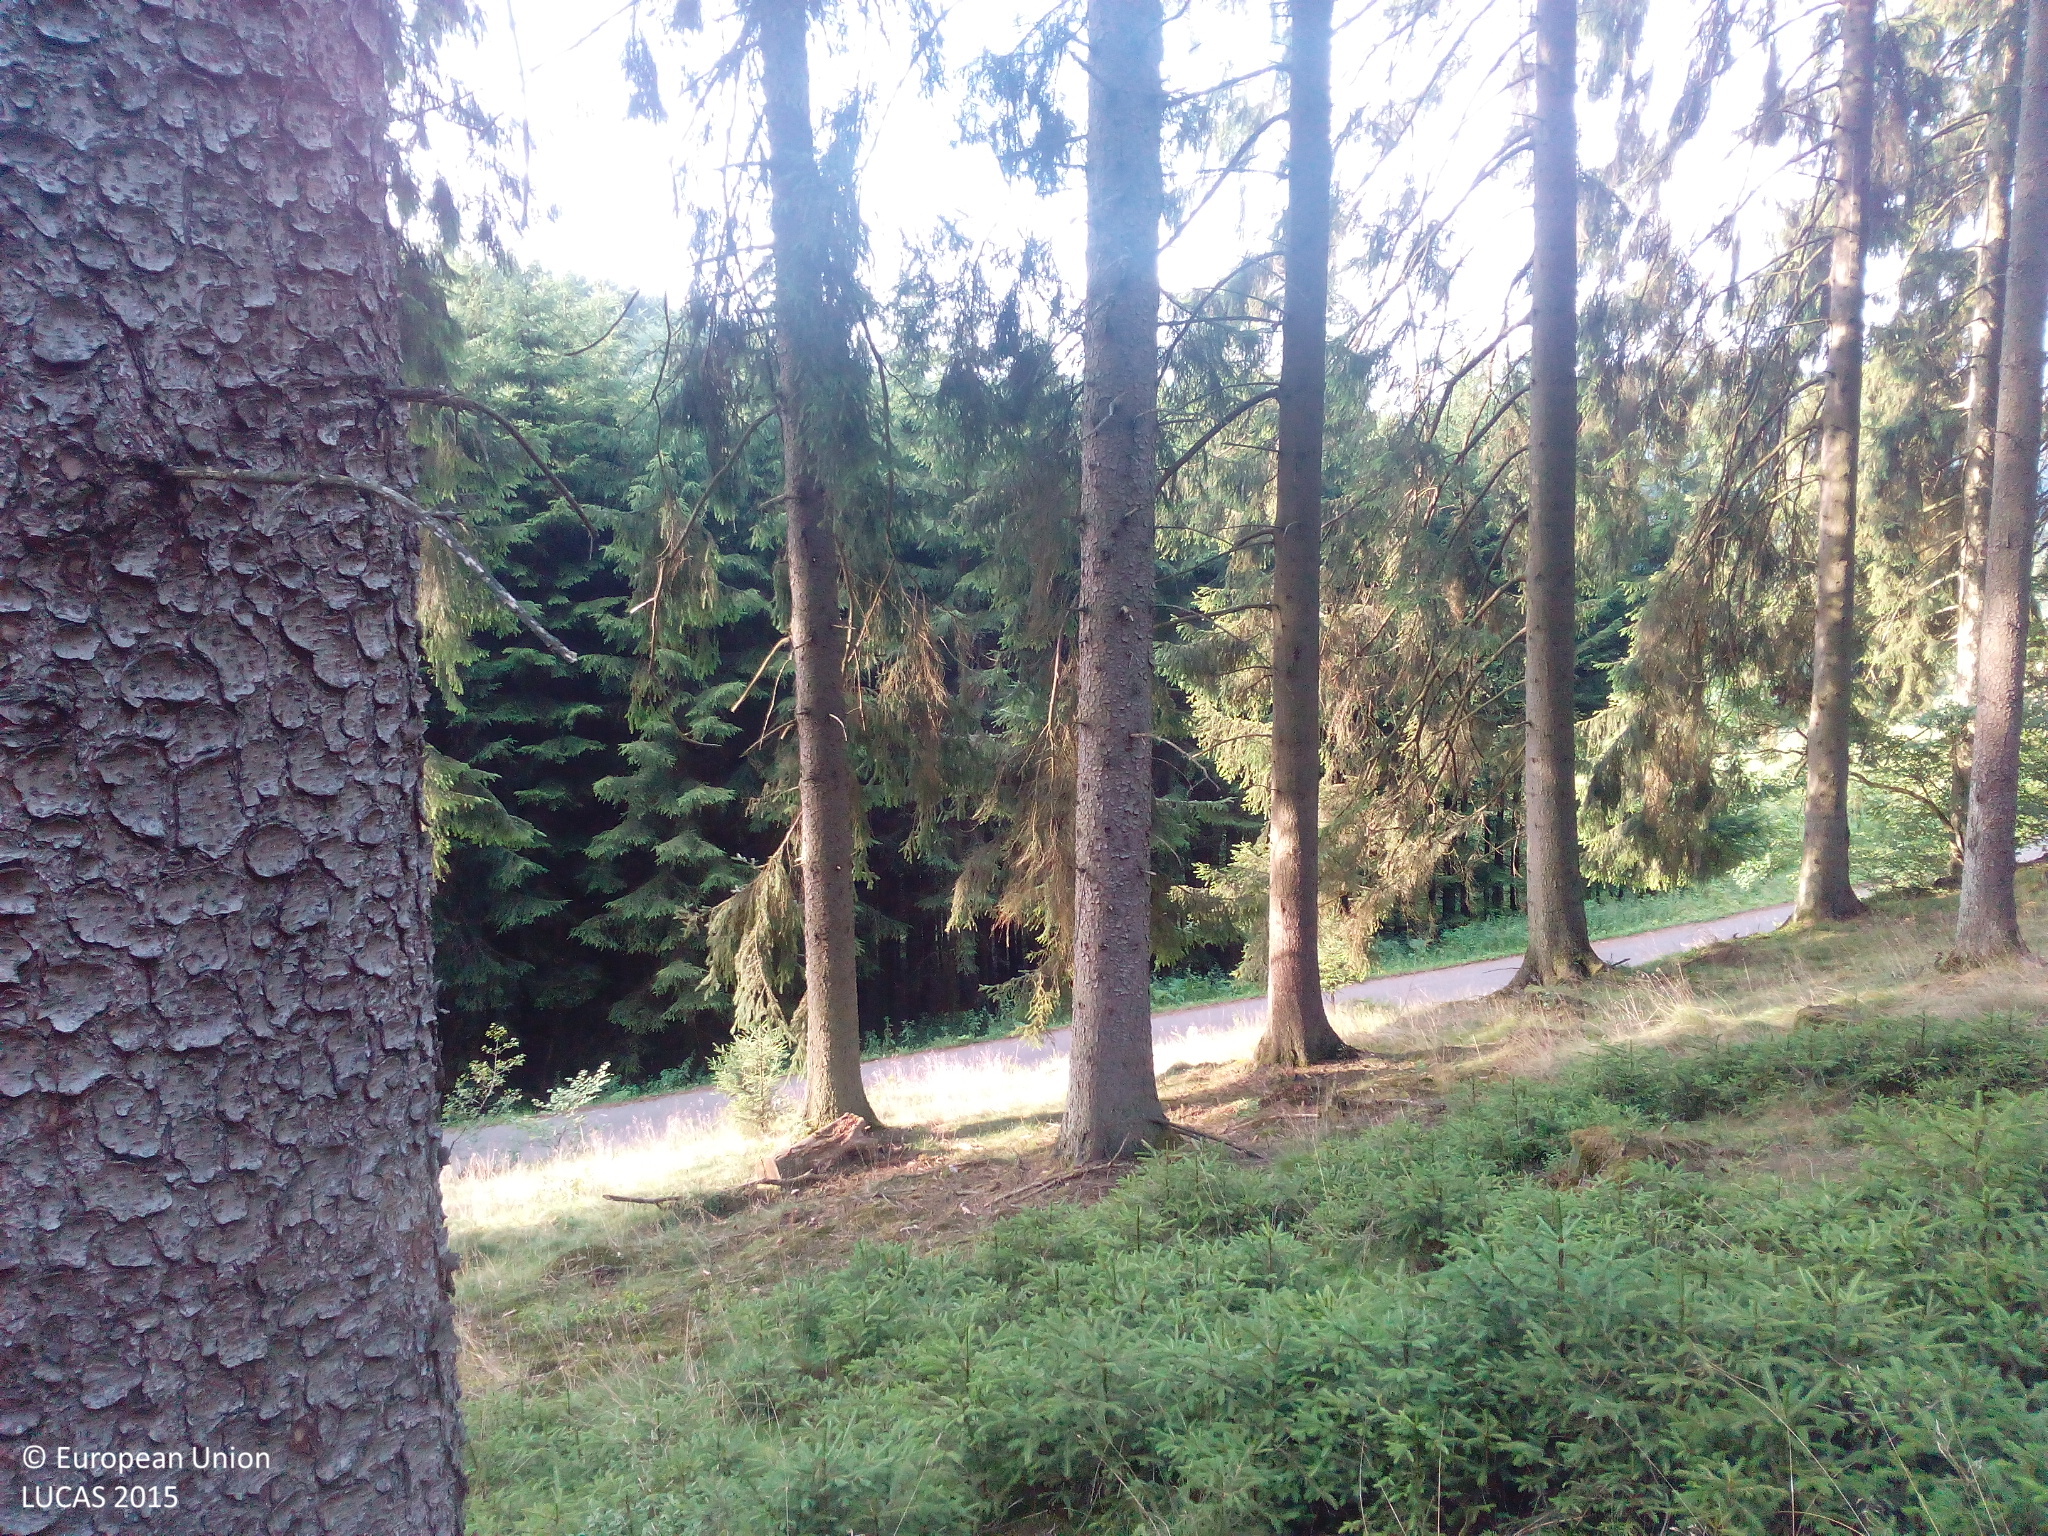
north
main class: Woodland
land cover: Spruce dominated coniferous woodland
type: hemiboreal forest and nemoral coniferous forest and mixed broadleaved-coniferous forest
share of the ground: > 75 %
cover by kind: coniferous forest trees 80 %, herbaceous plants 10 %, lichens and mosses 10 %
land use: Forestry
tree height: > 5 m
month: August
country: DE
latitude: 51.0838
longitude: 7.9875
